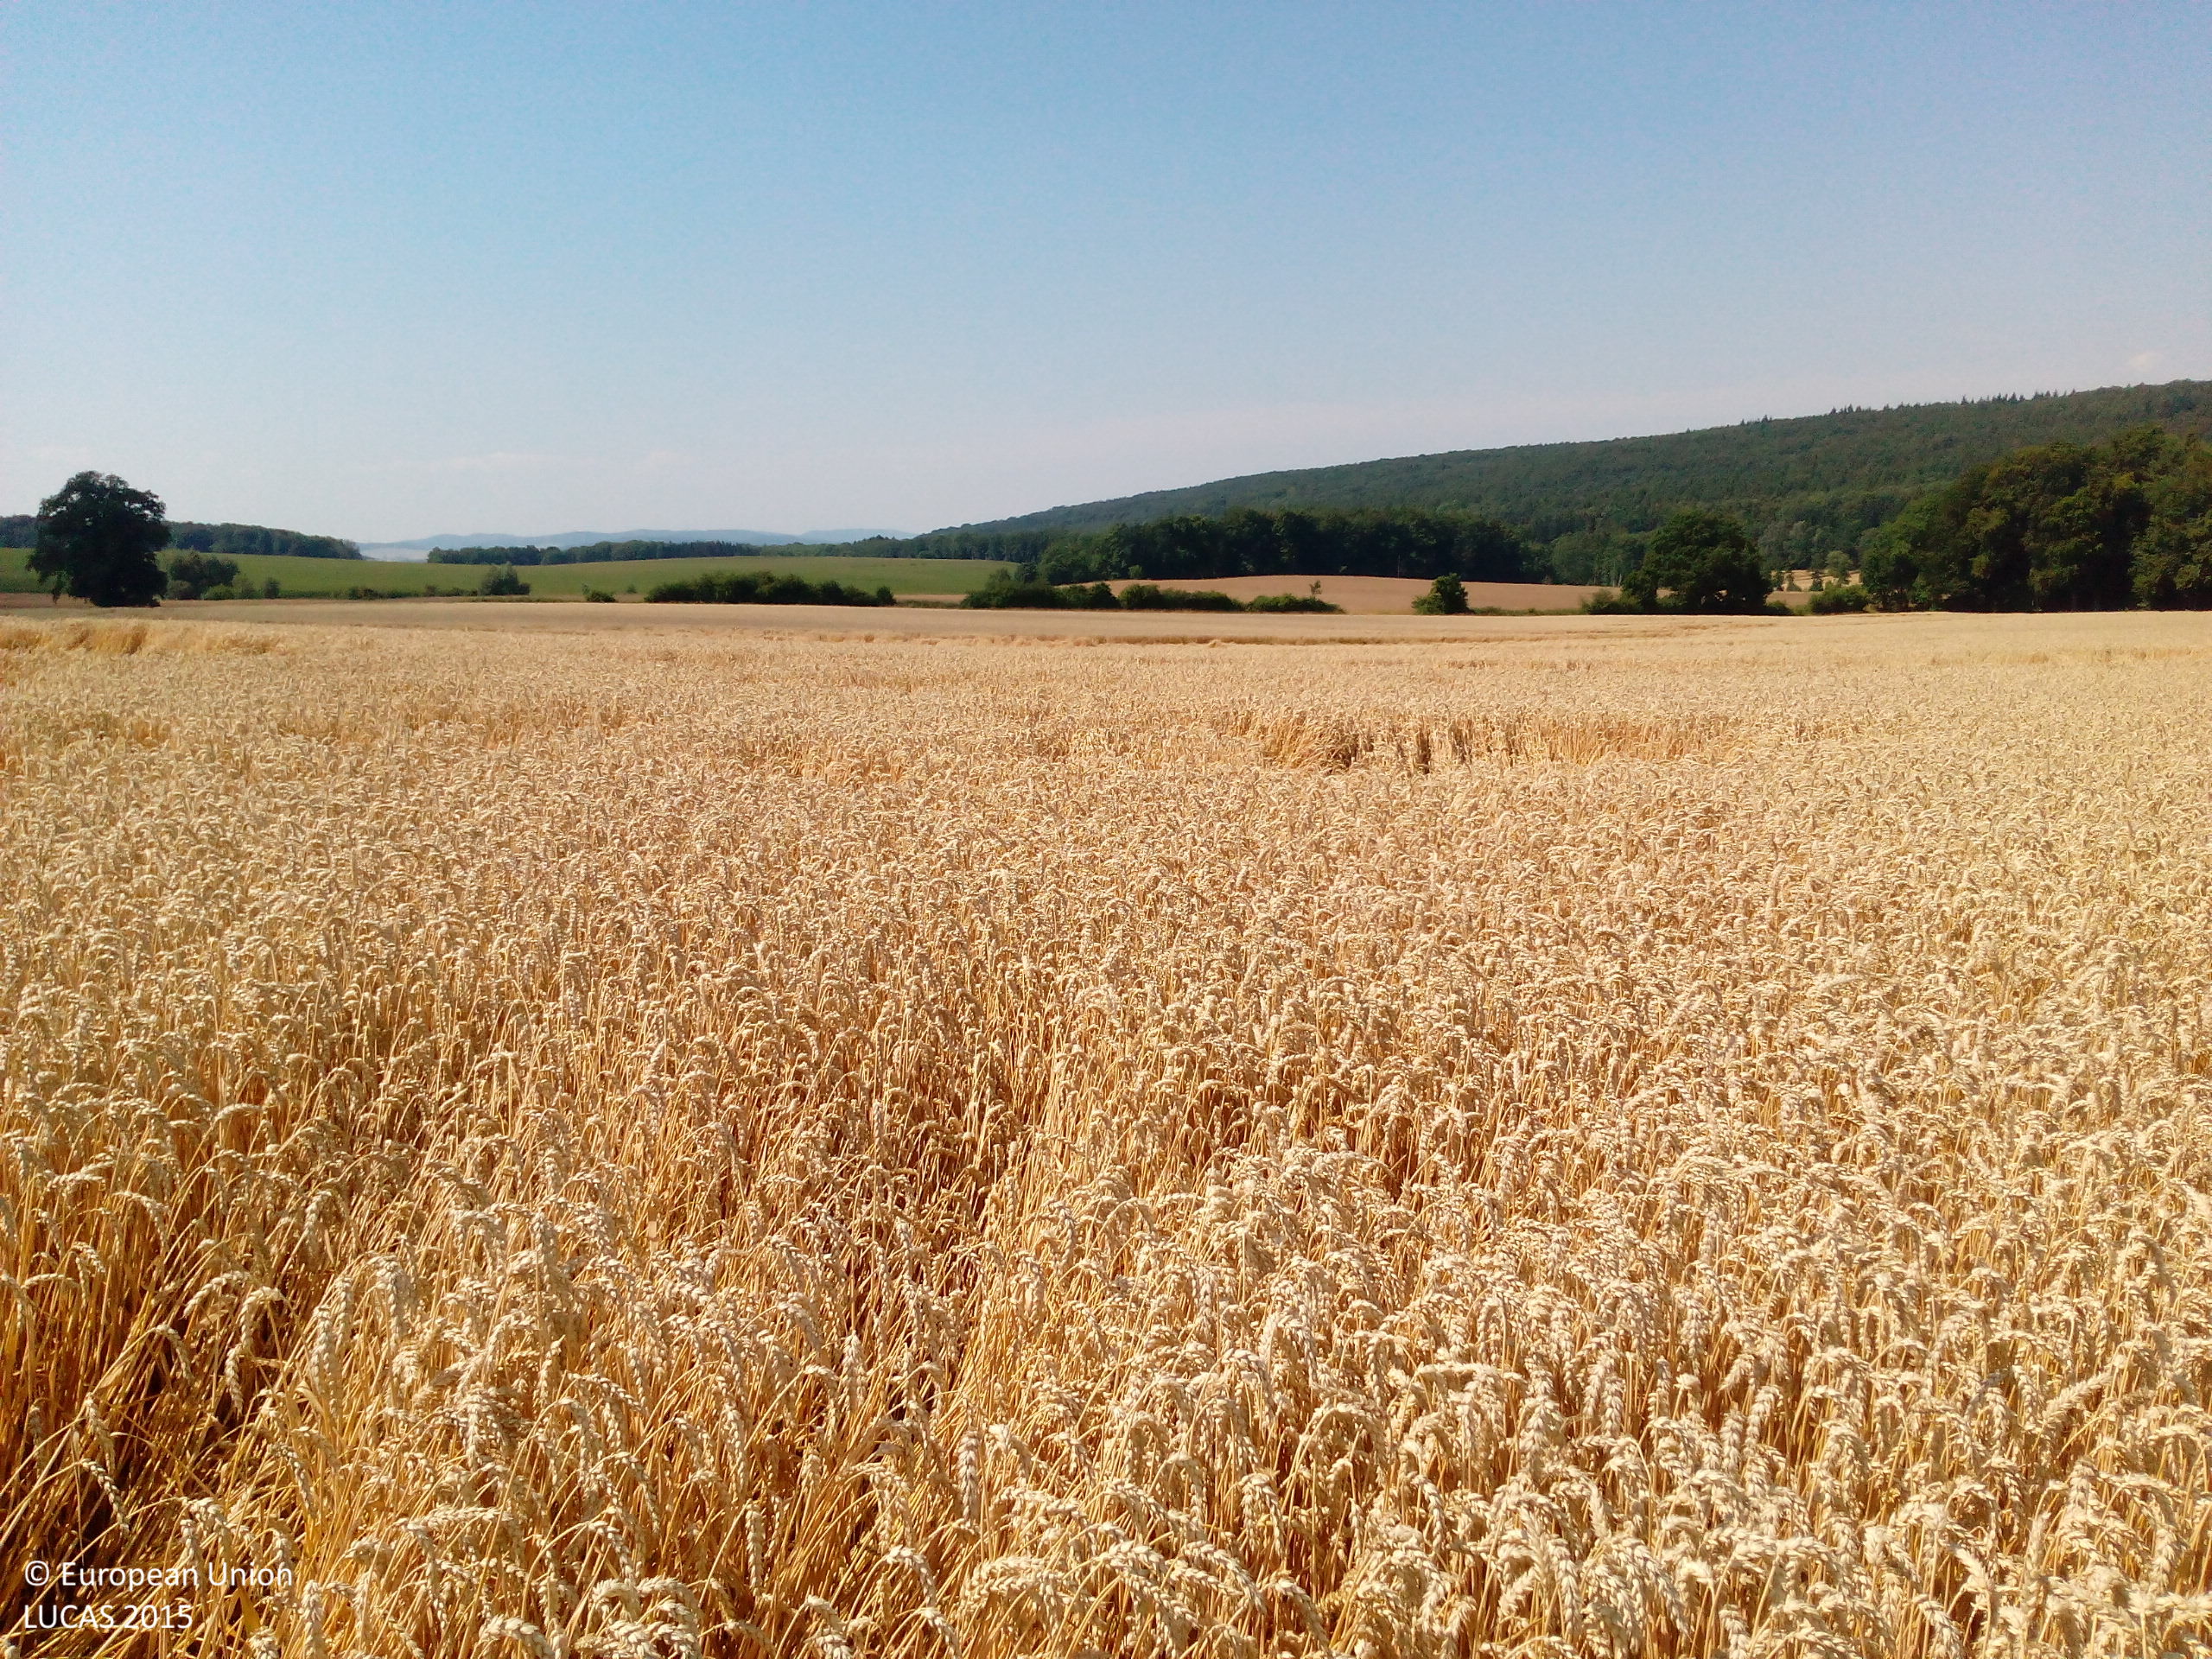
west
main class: Cropland
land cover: Common wheat
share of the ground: > 75 %
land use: Agriculture (excluding fallow land and kitchen gardens)
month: August
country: DE
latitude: 52.1075
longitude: 10.2773
